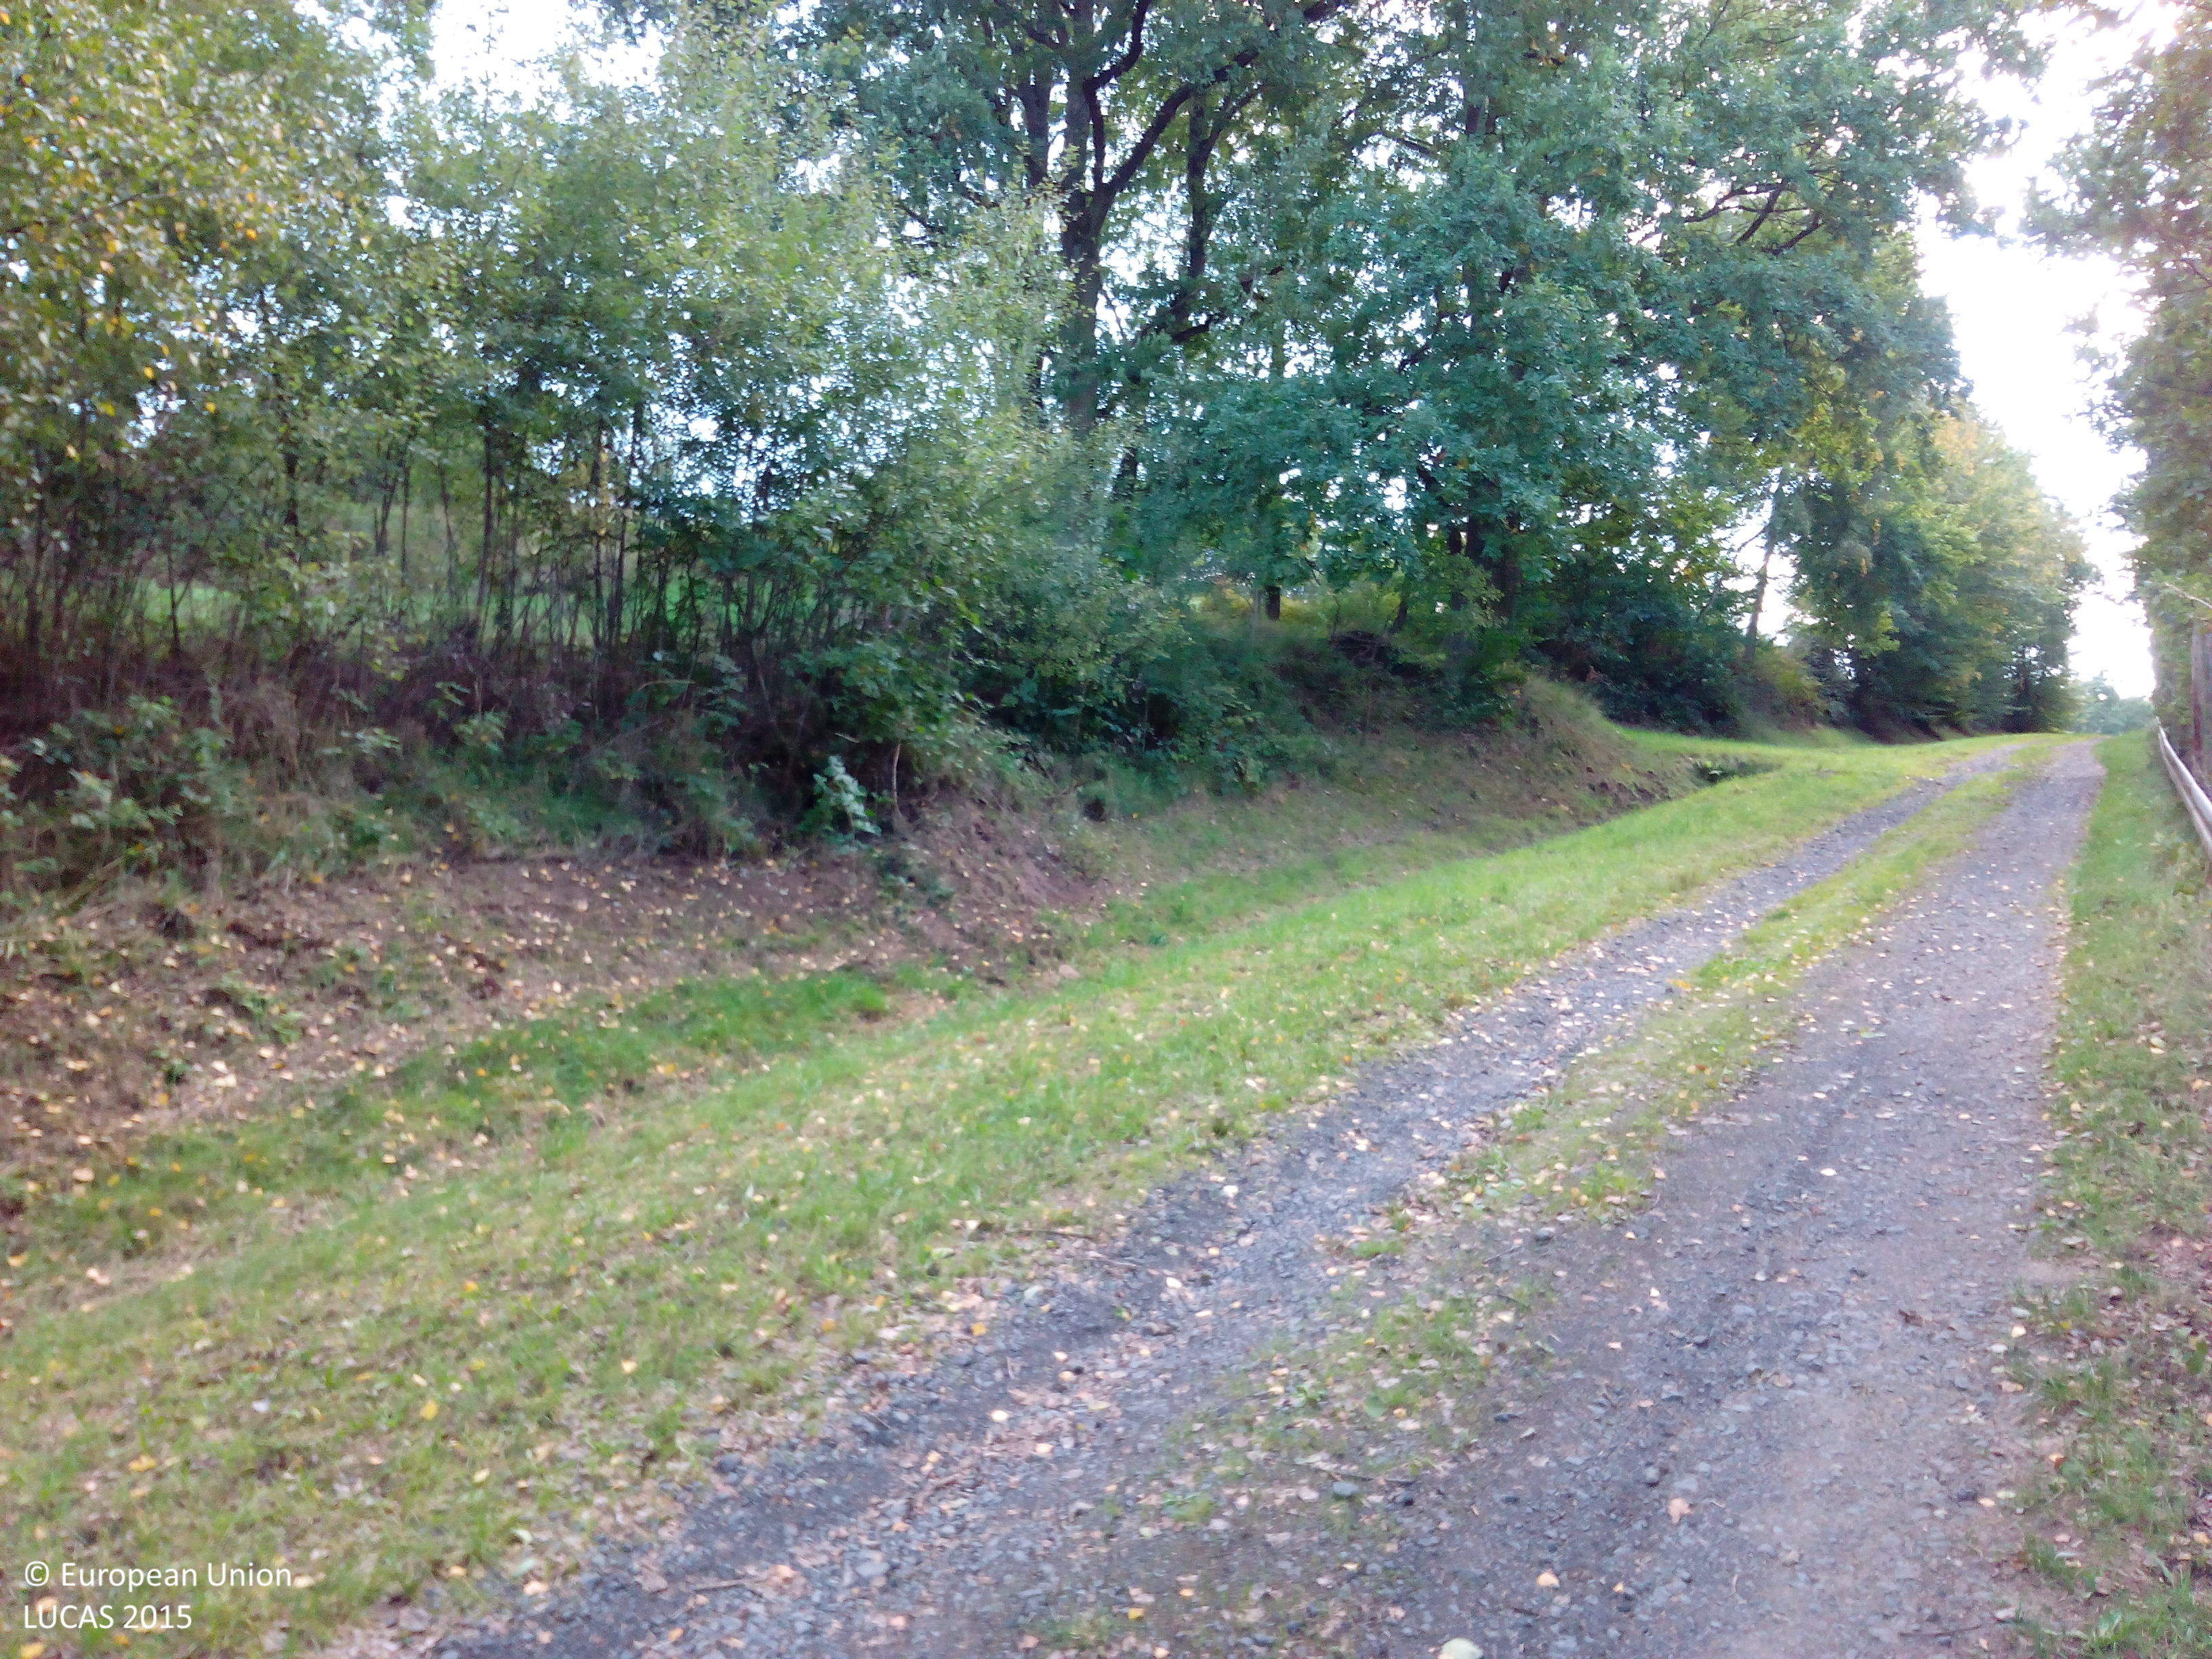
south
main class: Woodland
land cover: Other mixed woodland
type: hemiboreal forest and nemoral coniferous forest and mixed broadleaved-coniferous forest
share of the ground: > 75 %
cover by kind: coniferous forest trees 60 %, broadleaved forest trees 20 %, herbaceous plants 15 %, shrubs 5 %
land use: Semi-natural and natural areas not in use
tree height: > 5 m
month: September
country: DE
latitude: 50.2542
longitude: 9.3410
